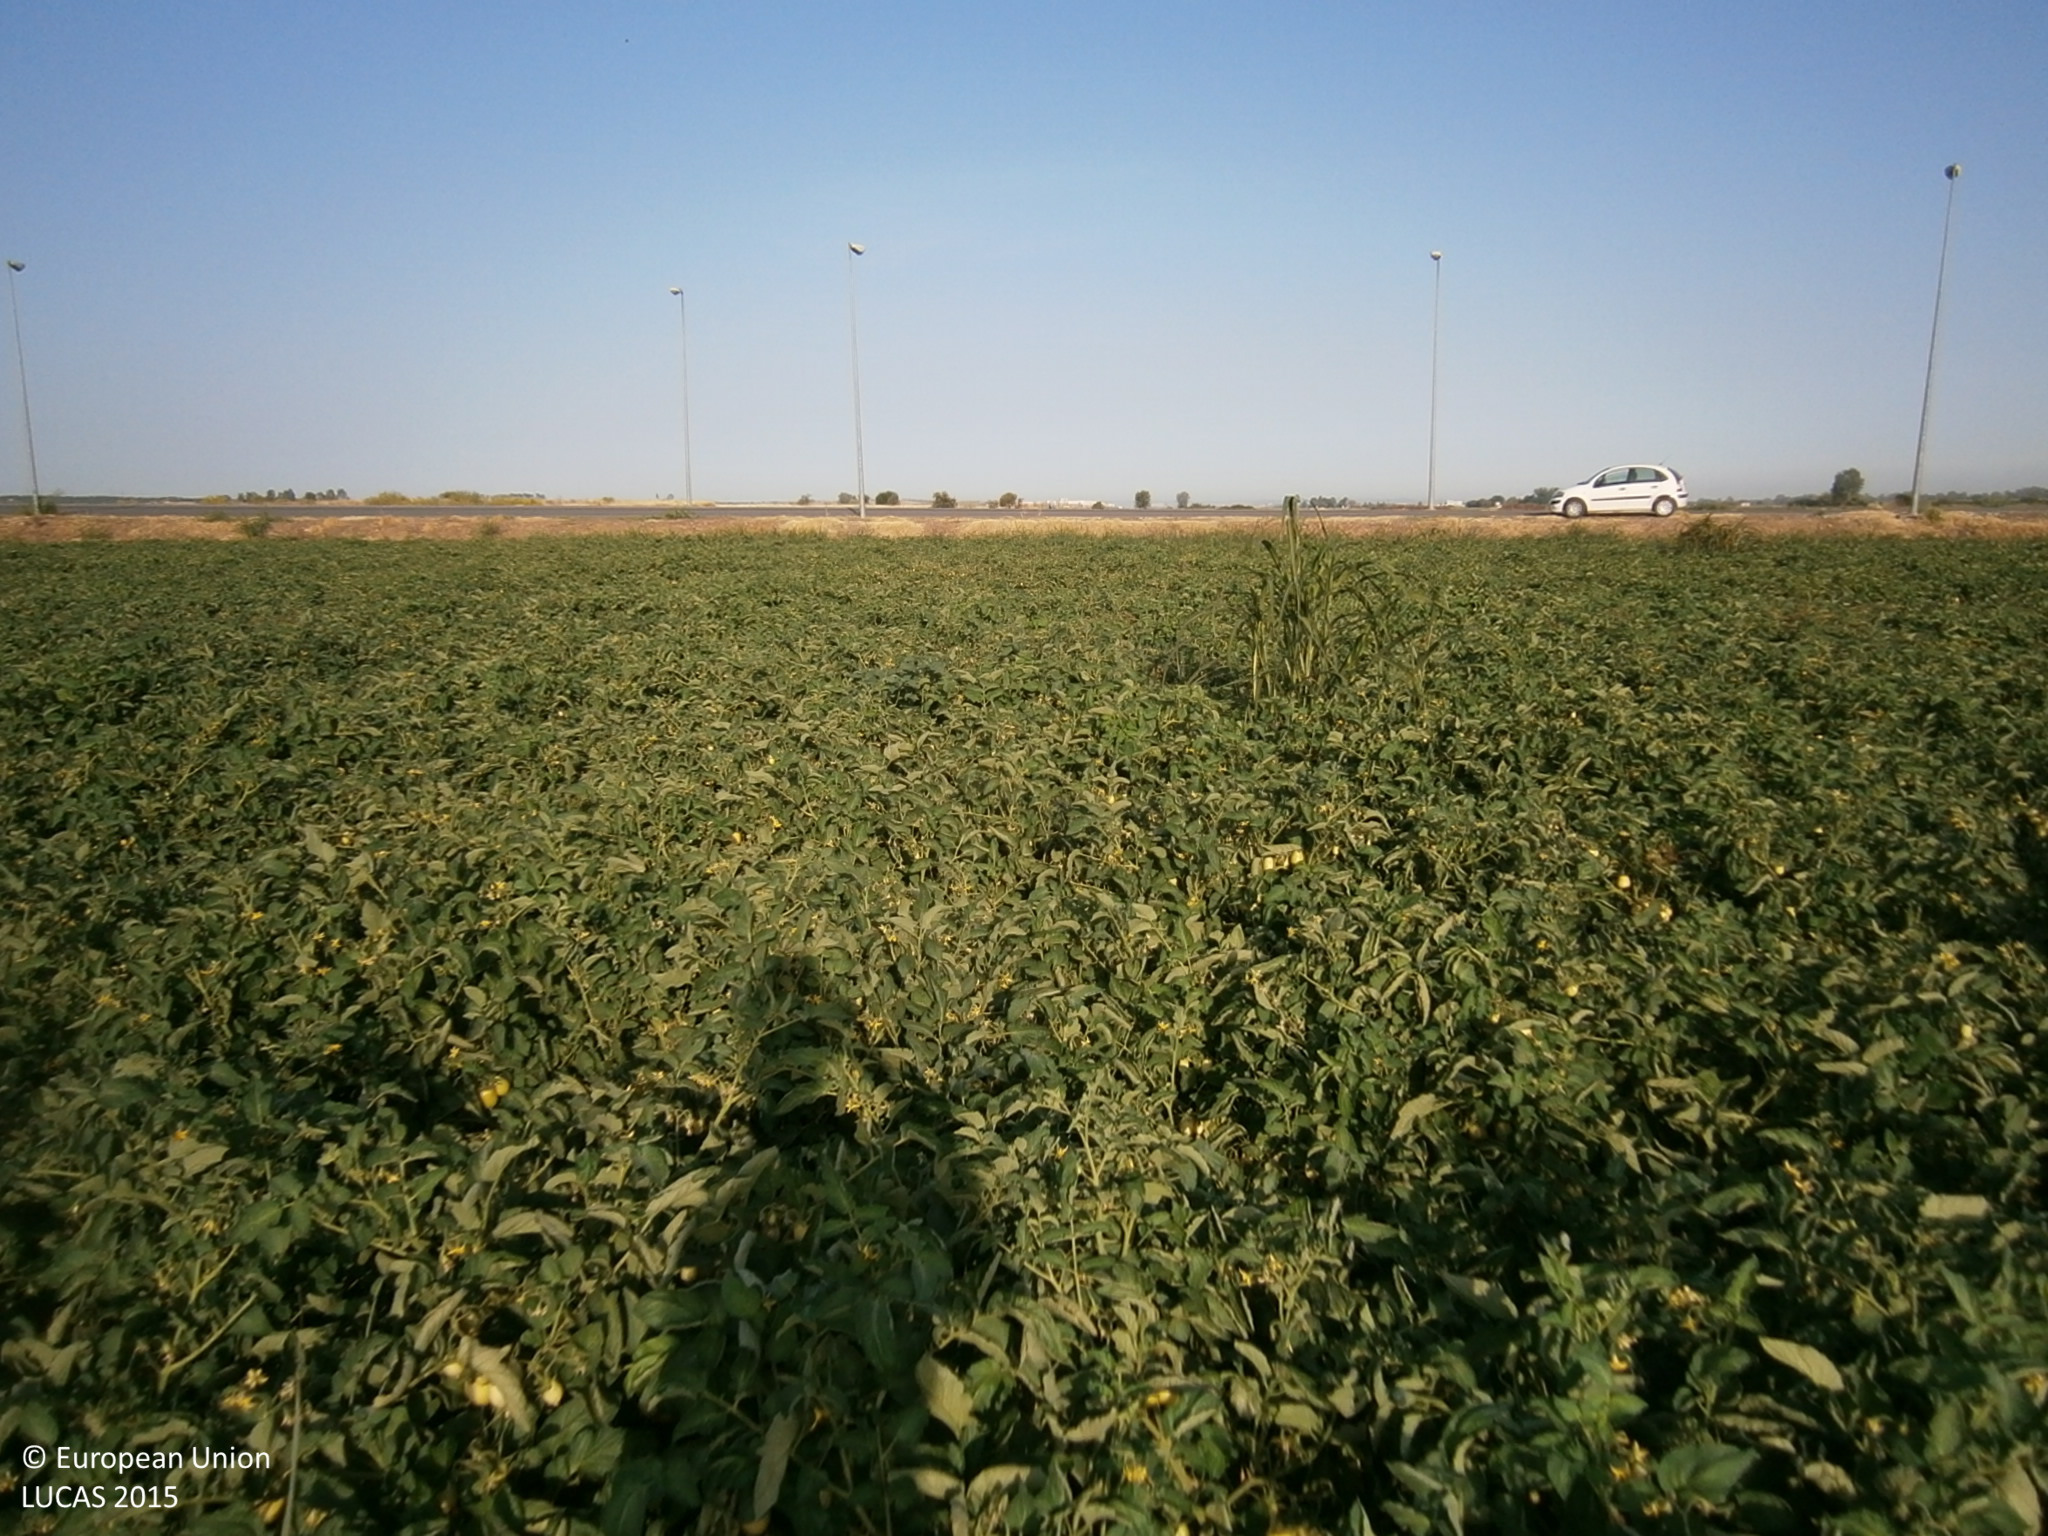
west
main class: Cropland
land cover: Tomatoes
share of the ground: > 75 %
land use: Agriculture (excluding fallow land and kitchen gardens)
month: July
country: ES
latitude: 38.8956
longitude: -6.8197
